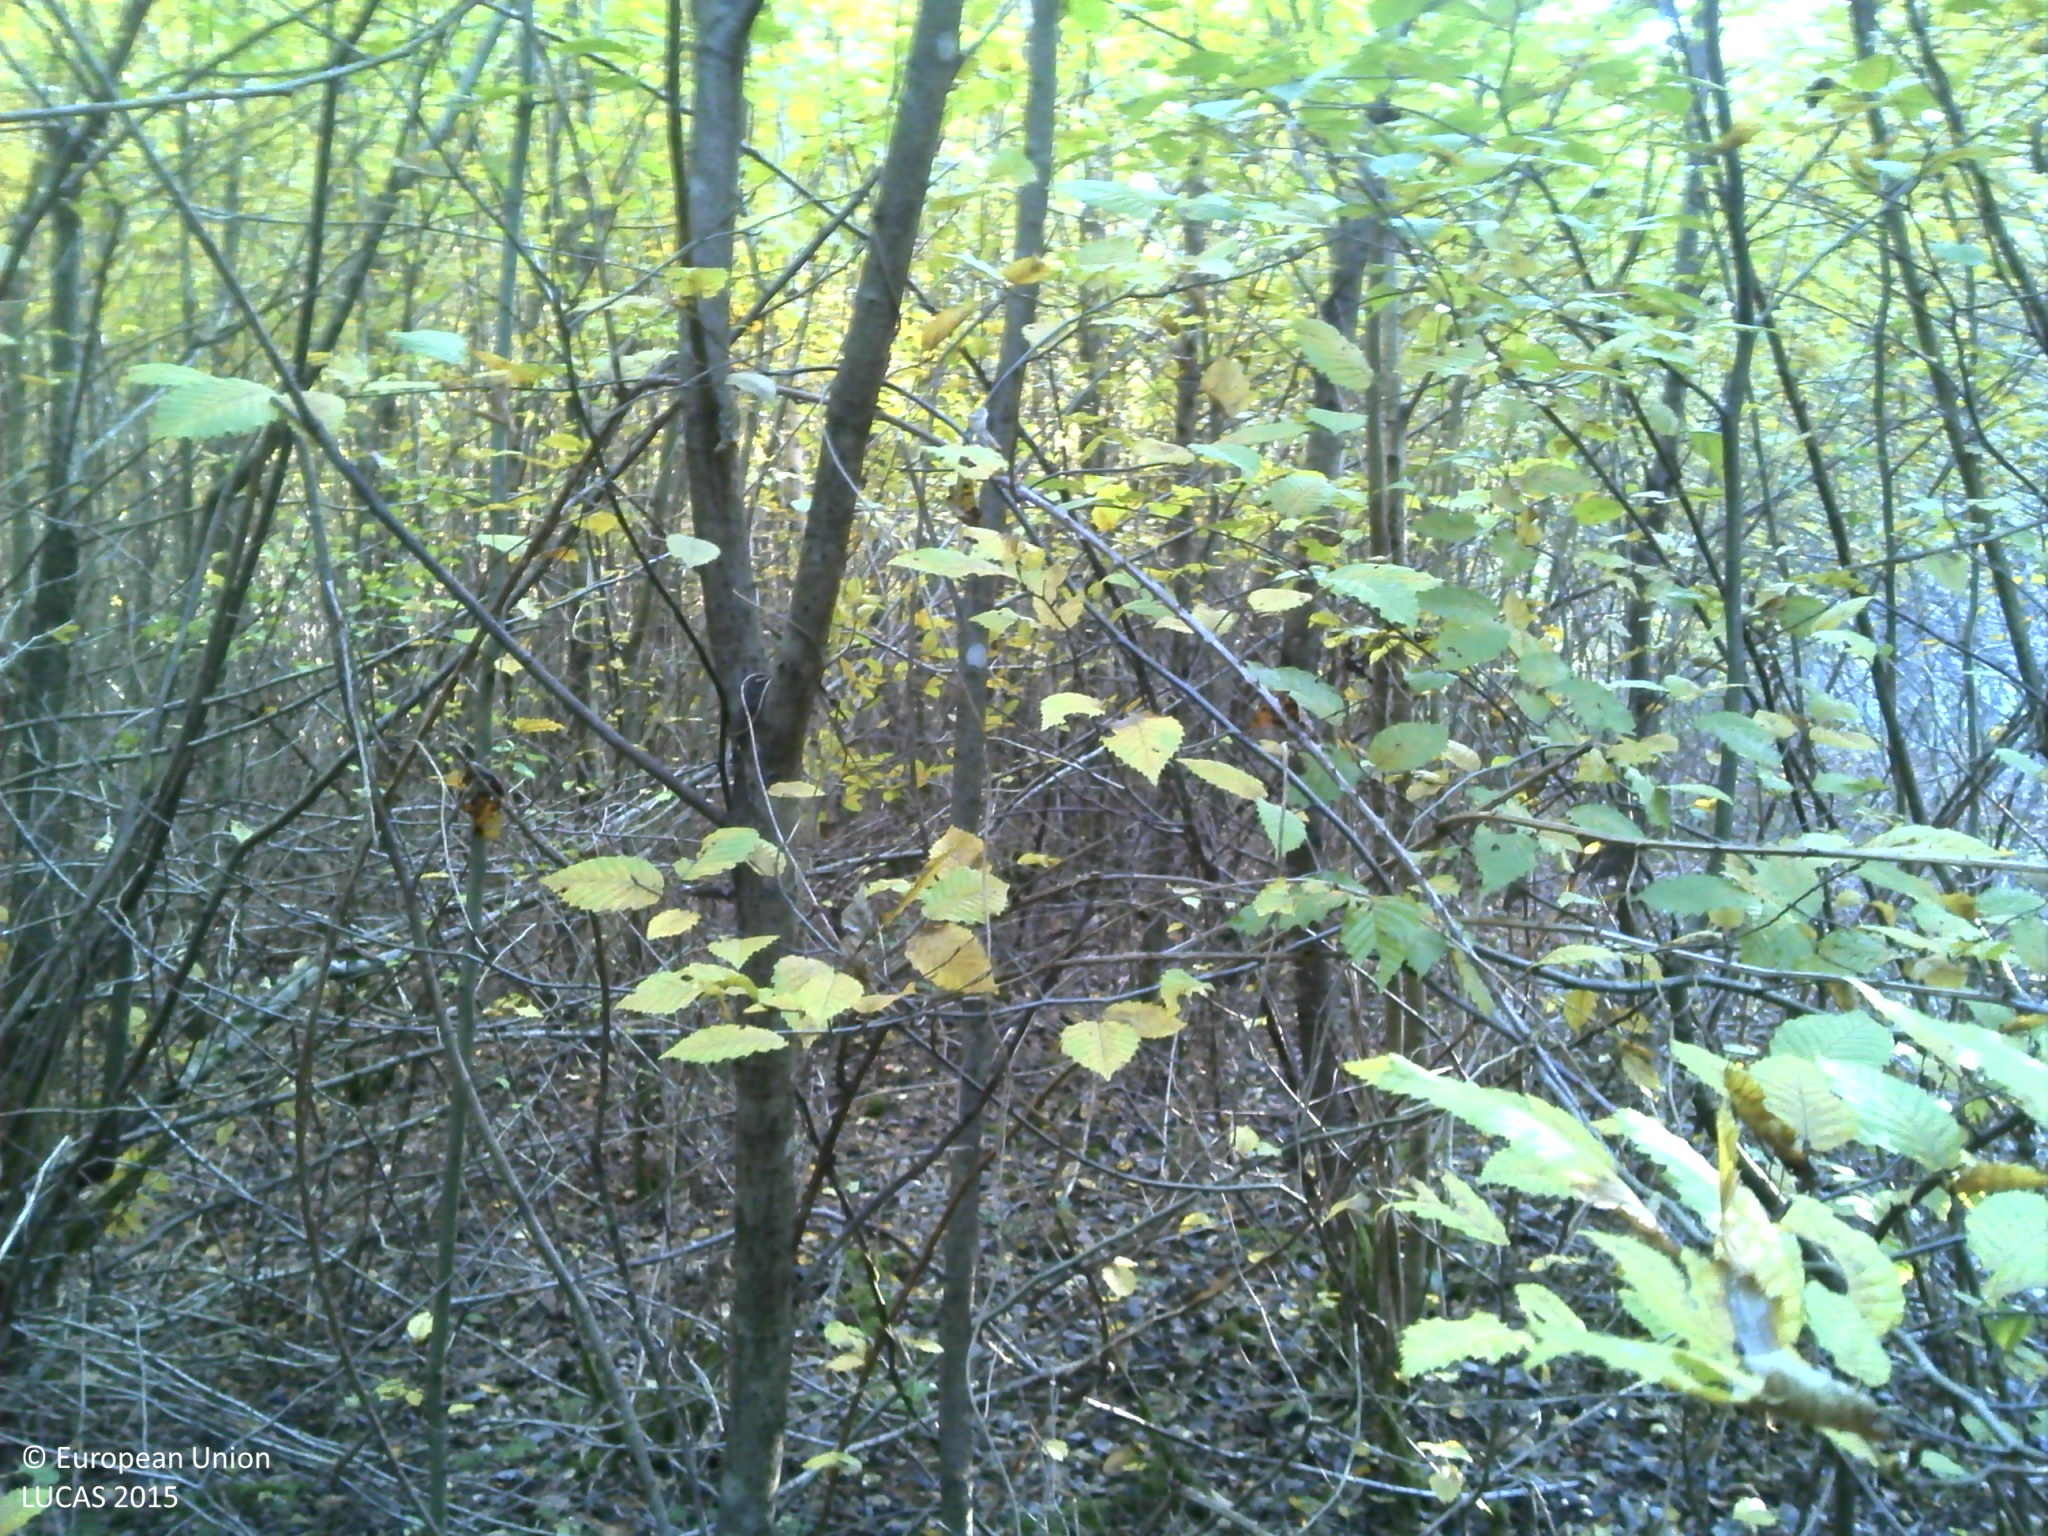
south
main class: Woodland
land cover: Broadleaved woodland
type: mesophytic deciduous forest
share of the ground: > 75 %
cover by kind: broadleaved forest trees 100 %
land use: Forestry
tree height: > 5 m
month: October
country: FR
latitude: 47.1877
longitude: 5.3425
